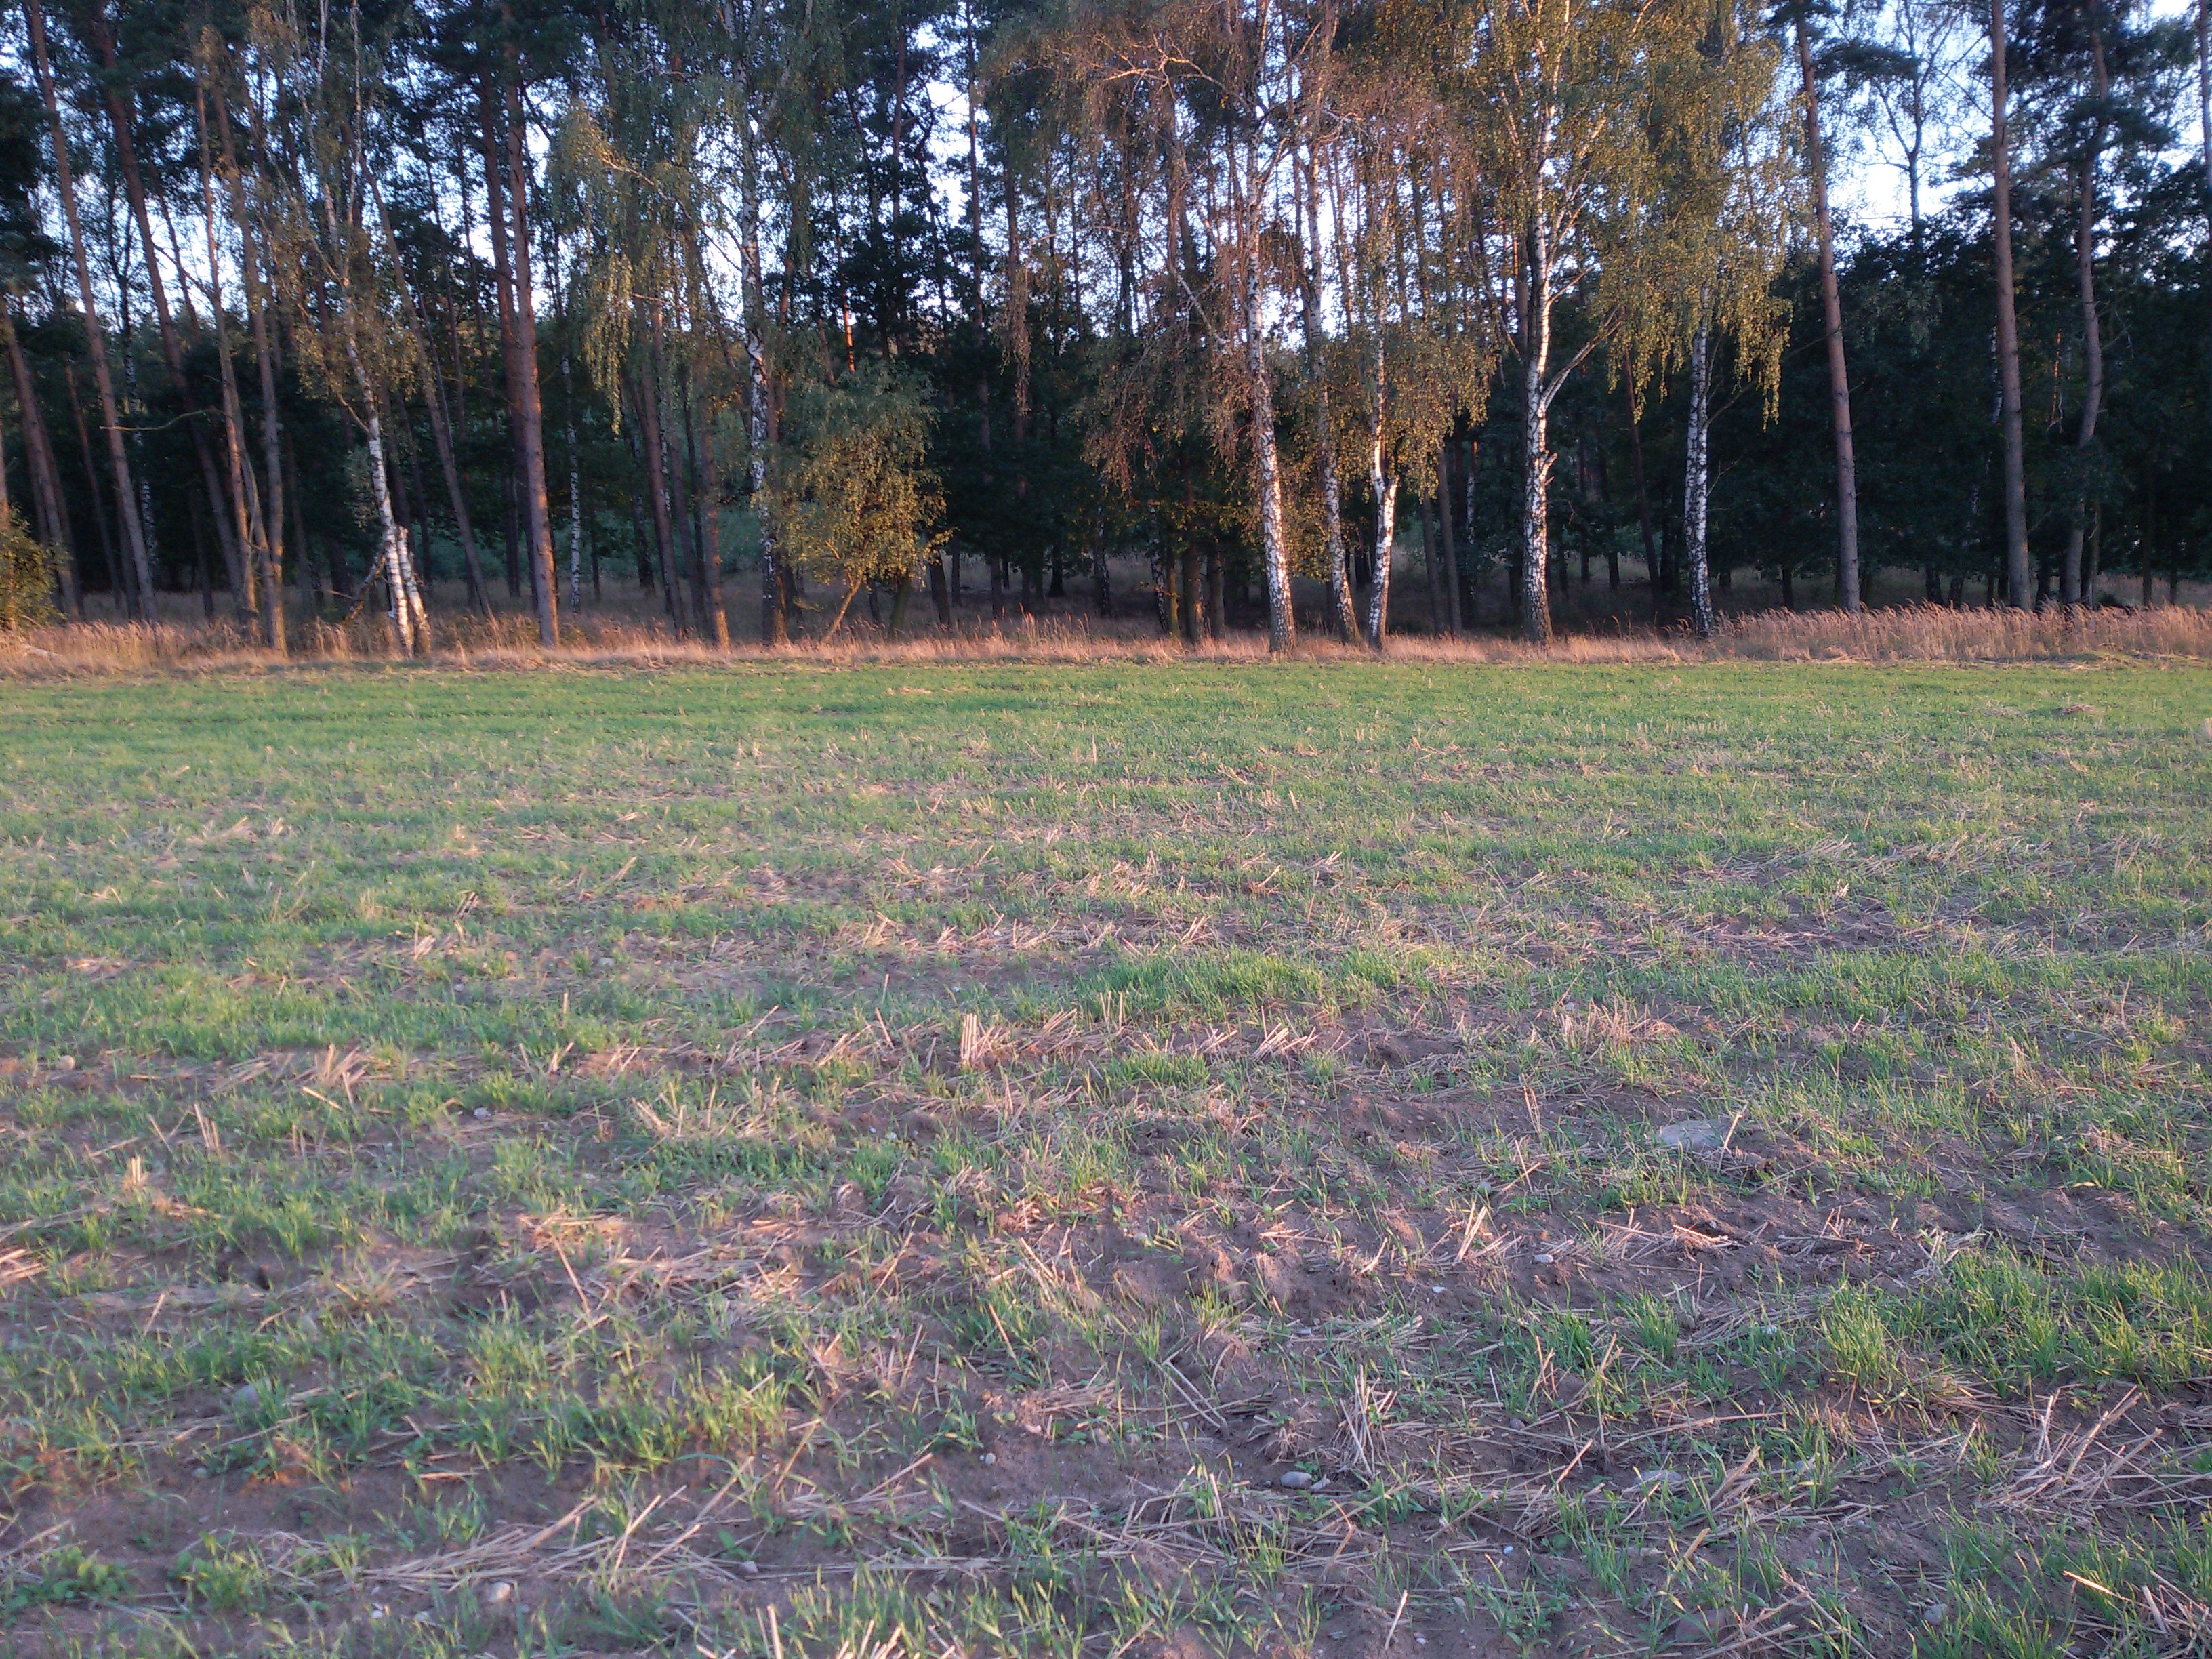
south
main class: Cropland
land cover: Rye
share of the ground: > 75 %
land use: Agriculture (excluding fallow land and kitchen gardens)
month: September
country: PL
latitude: 51.9103
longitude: 16.8269
